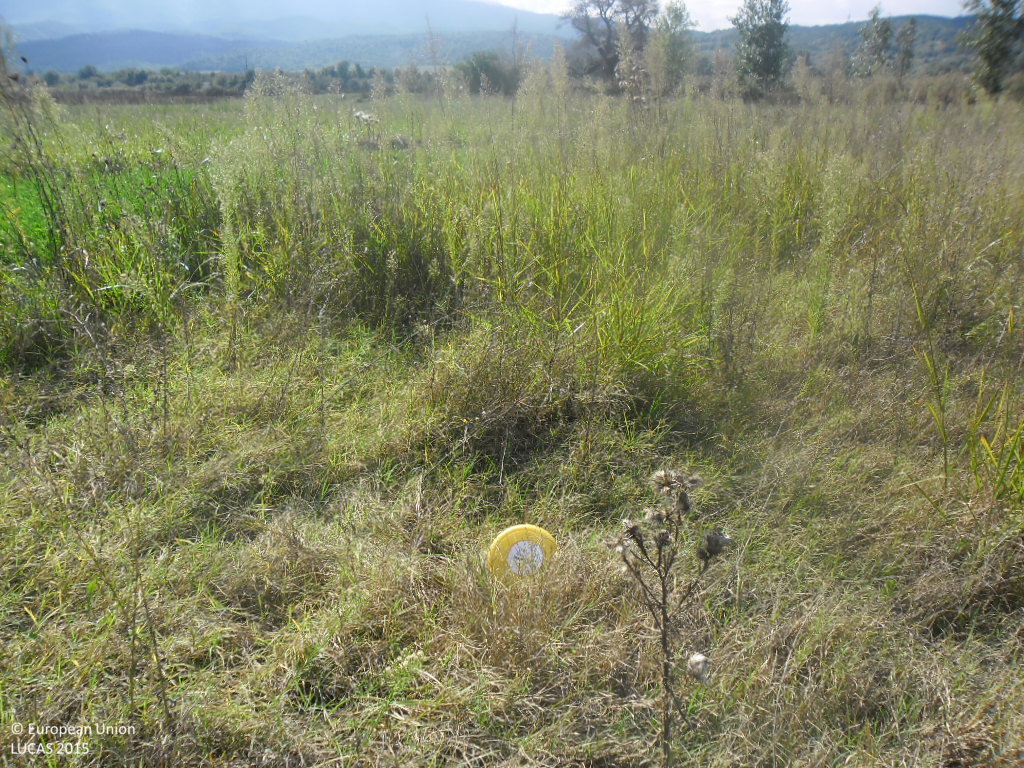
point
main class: Grassland
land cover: Spontaneously vegetated surfaces
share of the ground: > 75 %
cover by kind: herbaceous plants 100 %
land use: Agriculture (excluding fallow land and kitchen gardens)
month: October
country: BG
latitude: 41.4023
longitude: 23.3340
